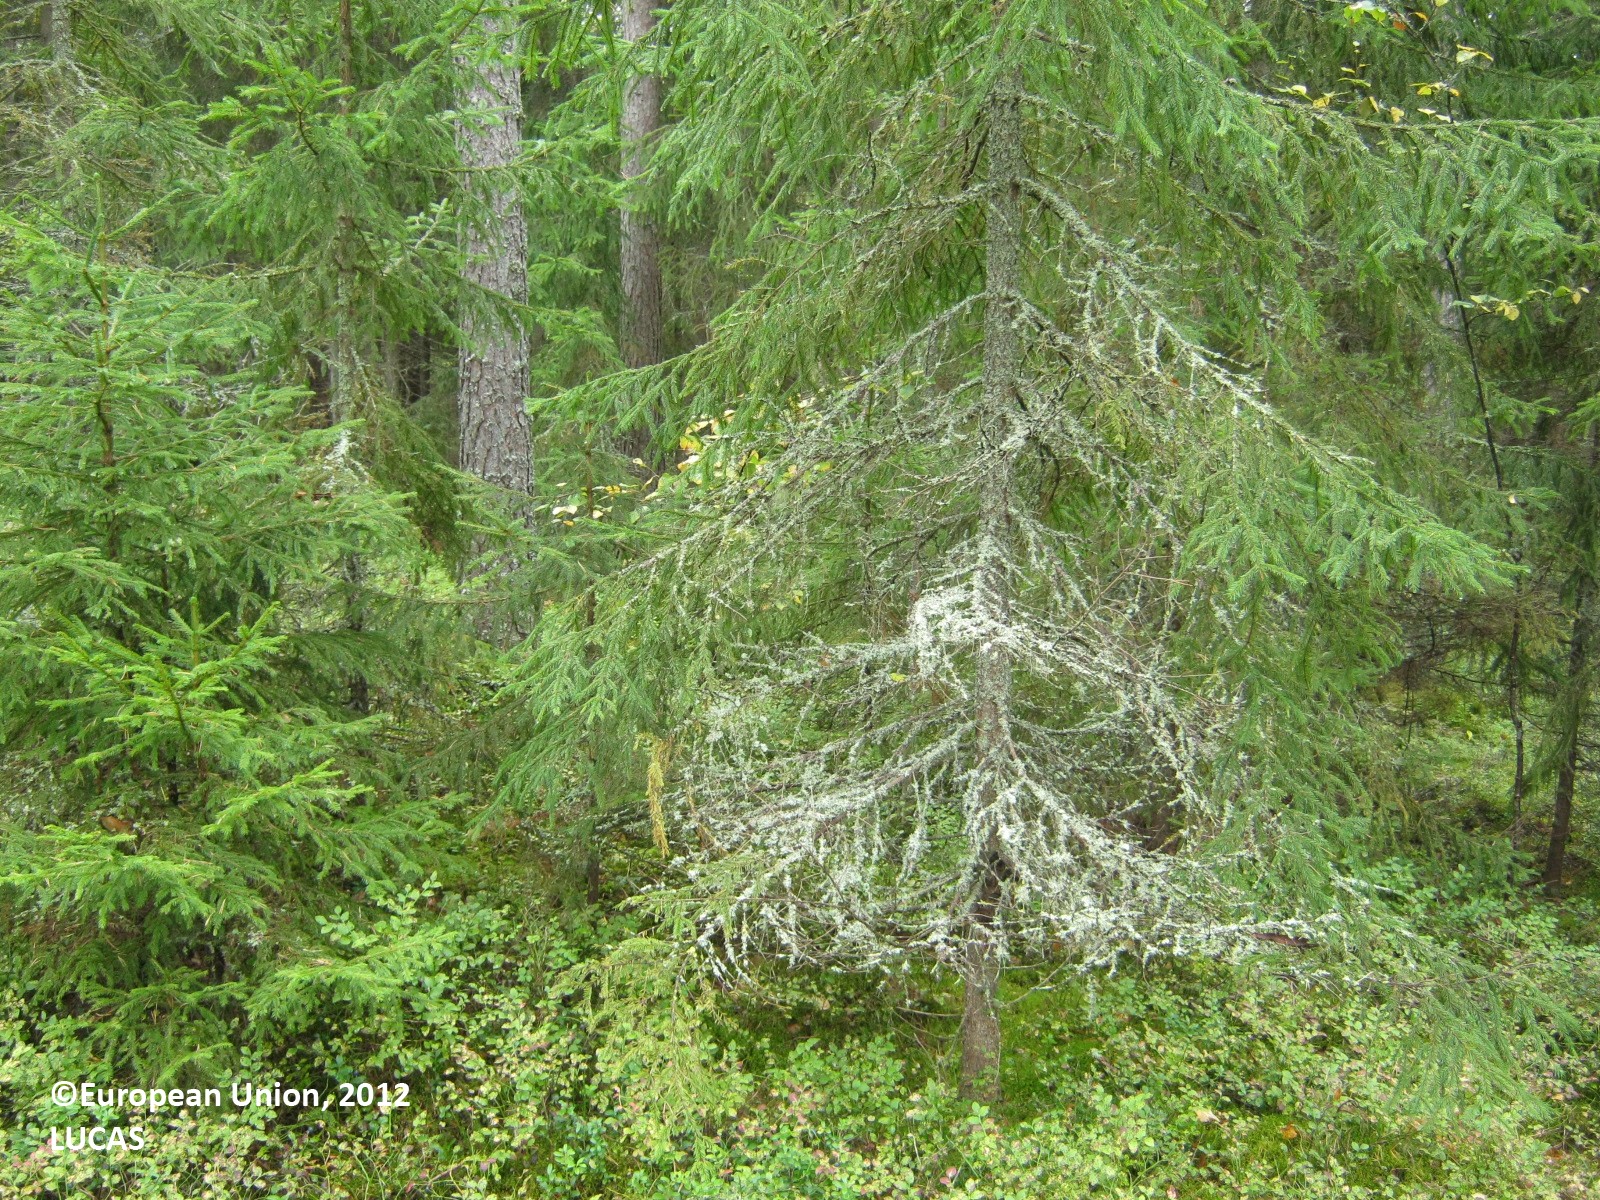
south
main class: Woodland
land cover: Other coniferous woodland
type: boreal forest
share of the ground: 50 - 75 %
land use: Forestry
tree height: > 5 m
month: September
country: FI
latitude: 60.6415
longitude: 27.6906
